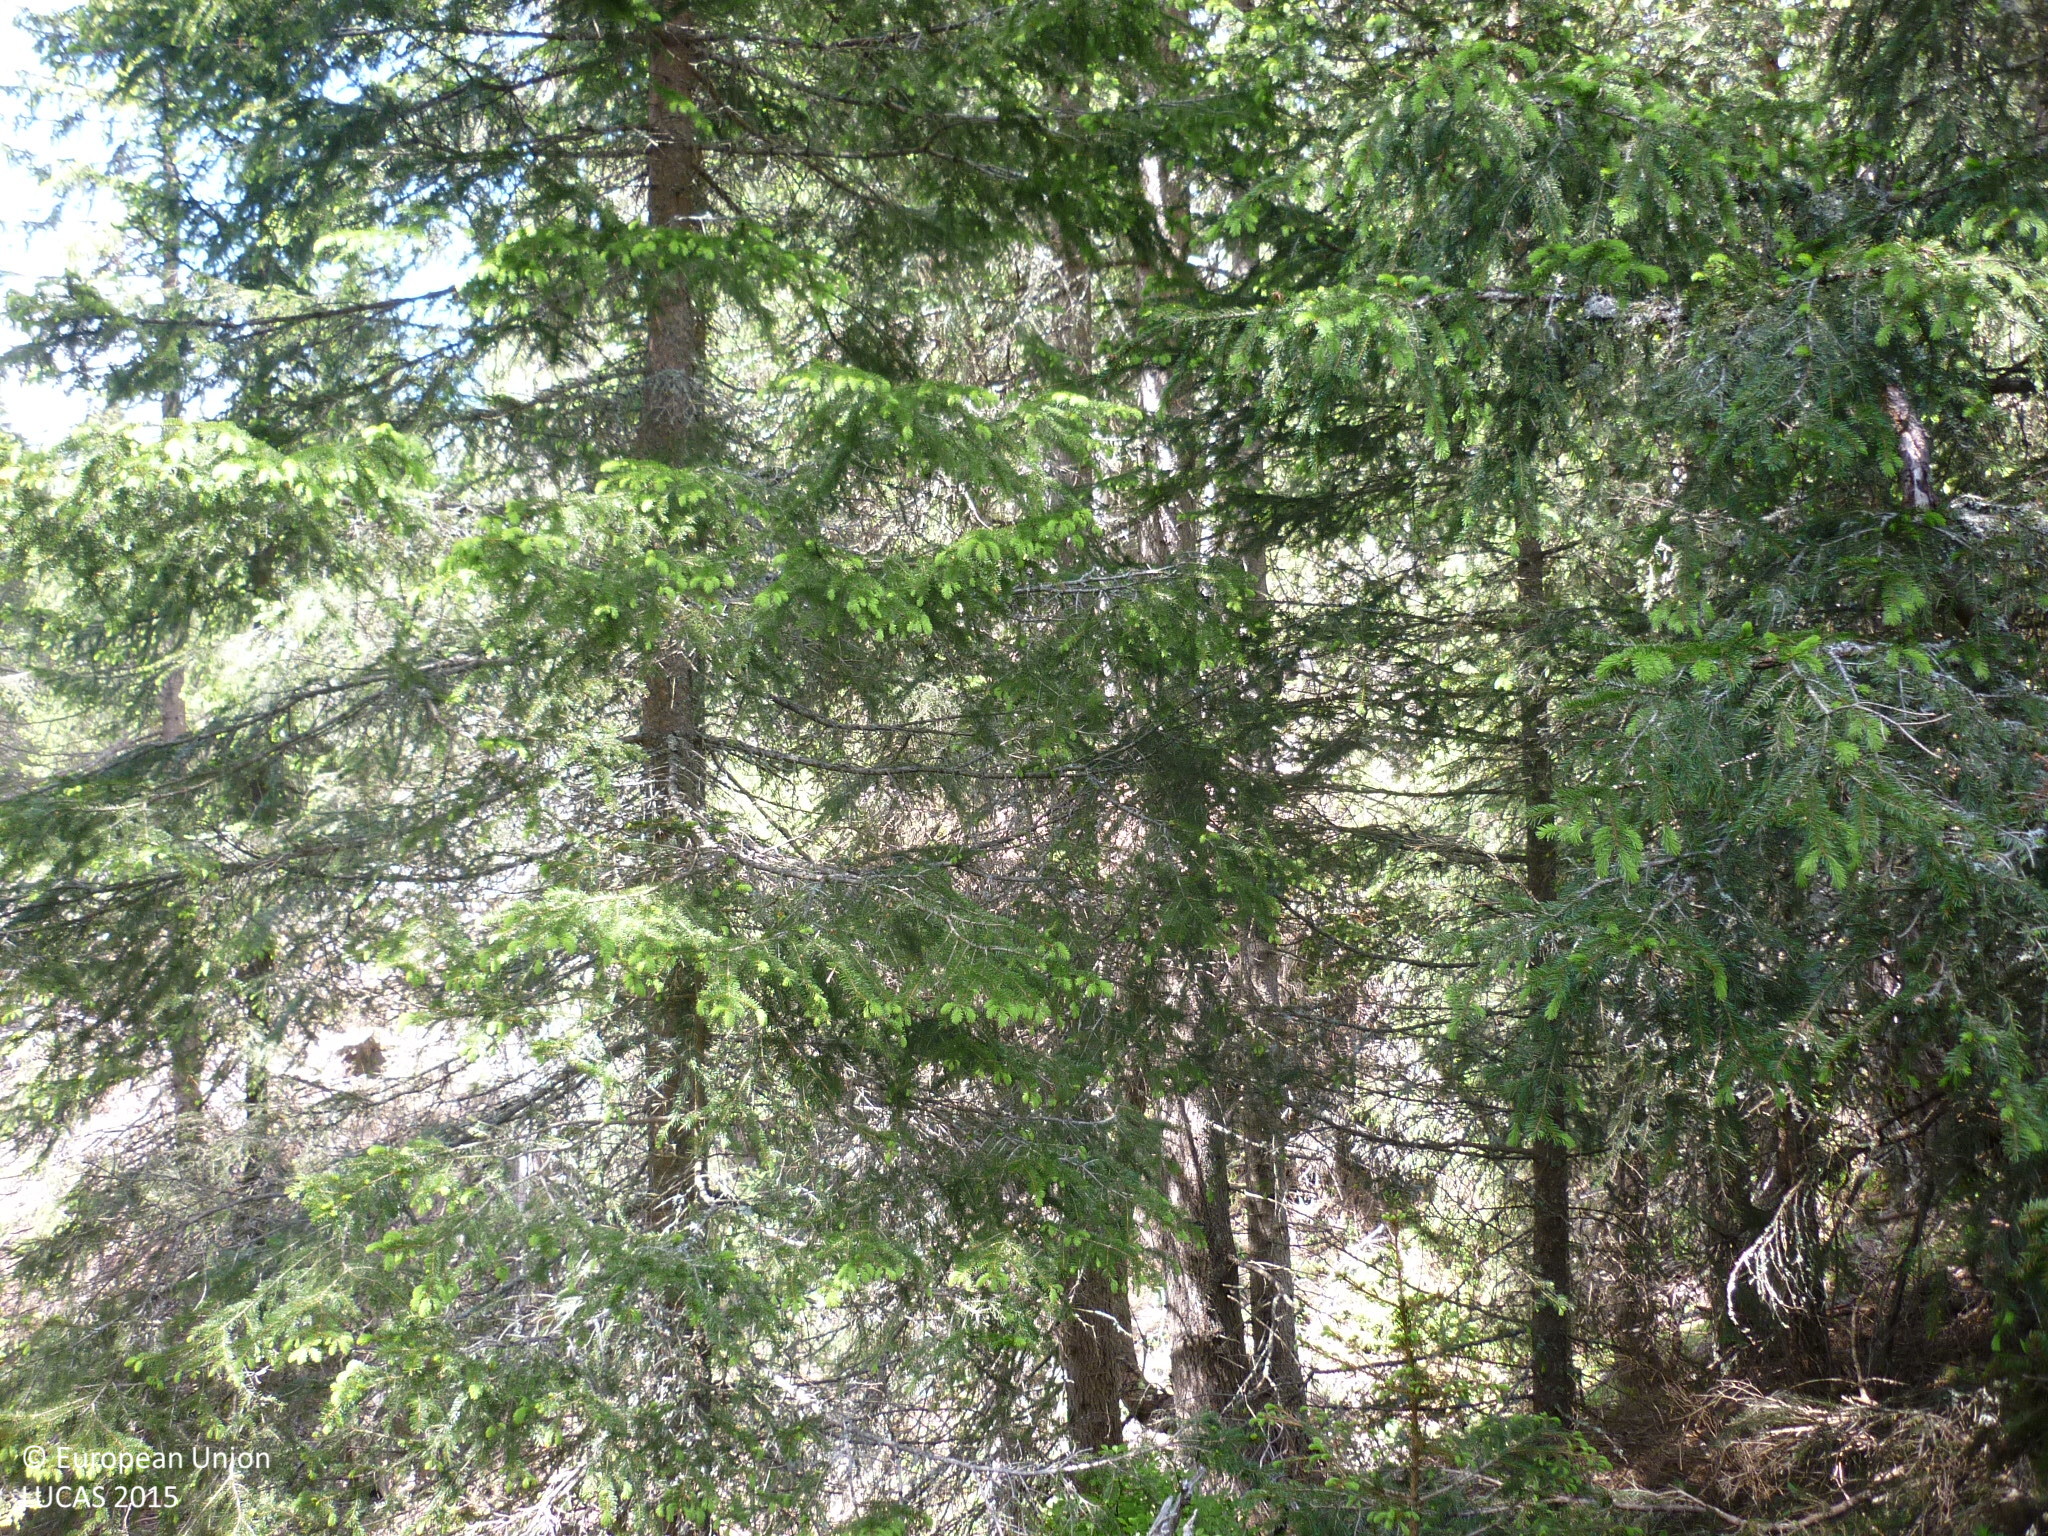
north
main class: Woodland
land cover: Spruce dominated coniferous woodland
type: alpine coniferous forest
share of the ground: > 75 %
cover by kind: coniferous forest trees 80 %, herbaceous plants 15 %, unconsolidated bare surface 5 %
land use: Forestry
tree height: > 5 m
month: June
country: AT
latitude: 47.2537
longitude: 14.3723
